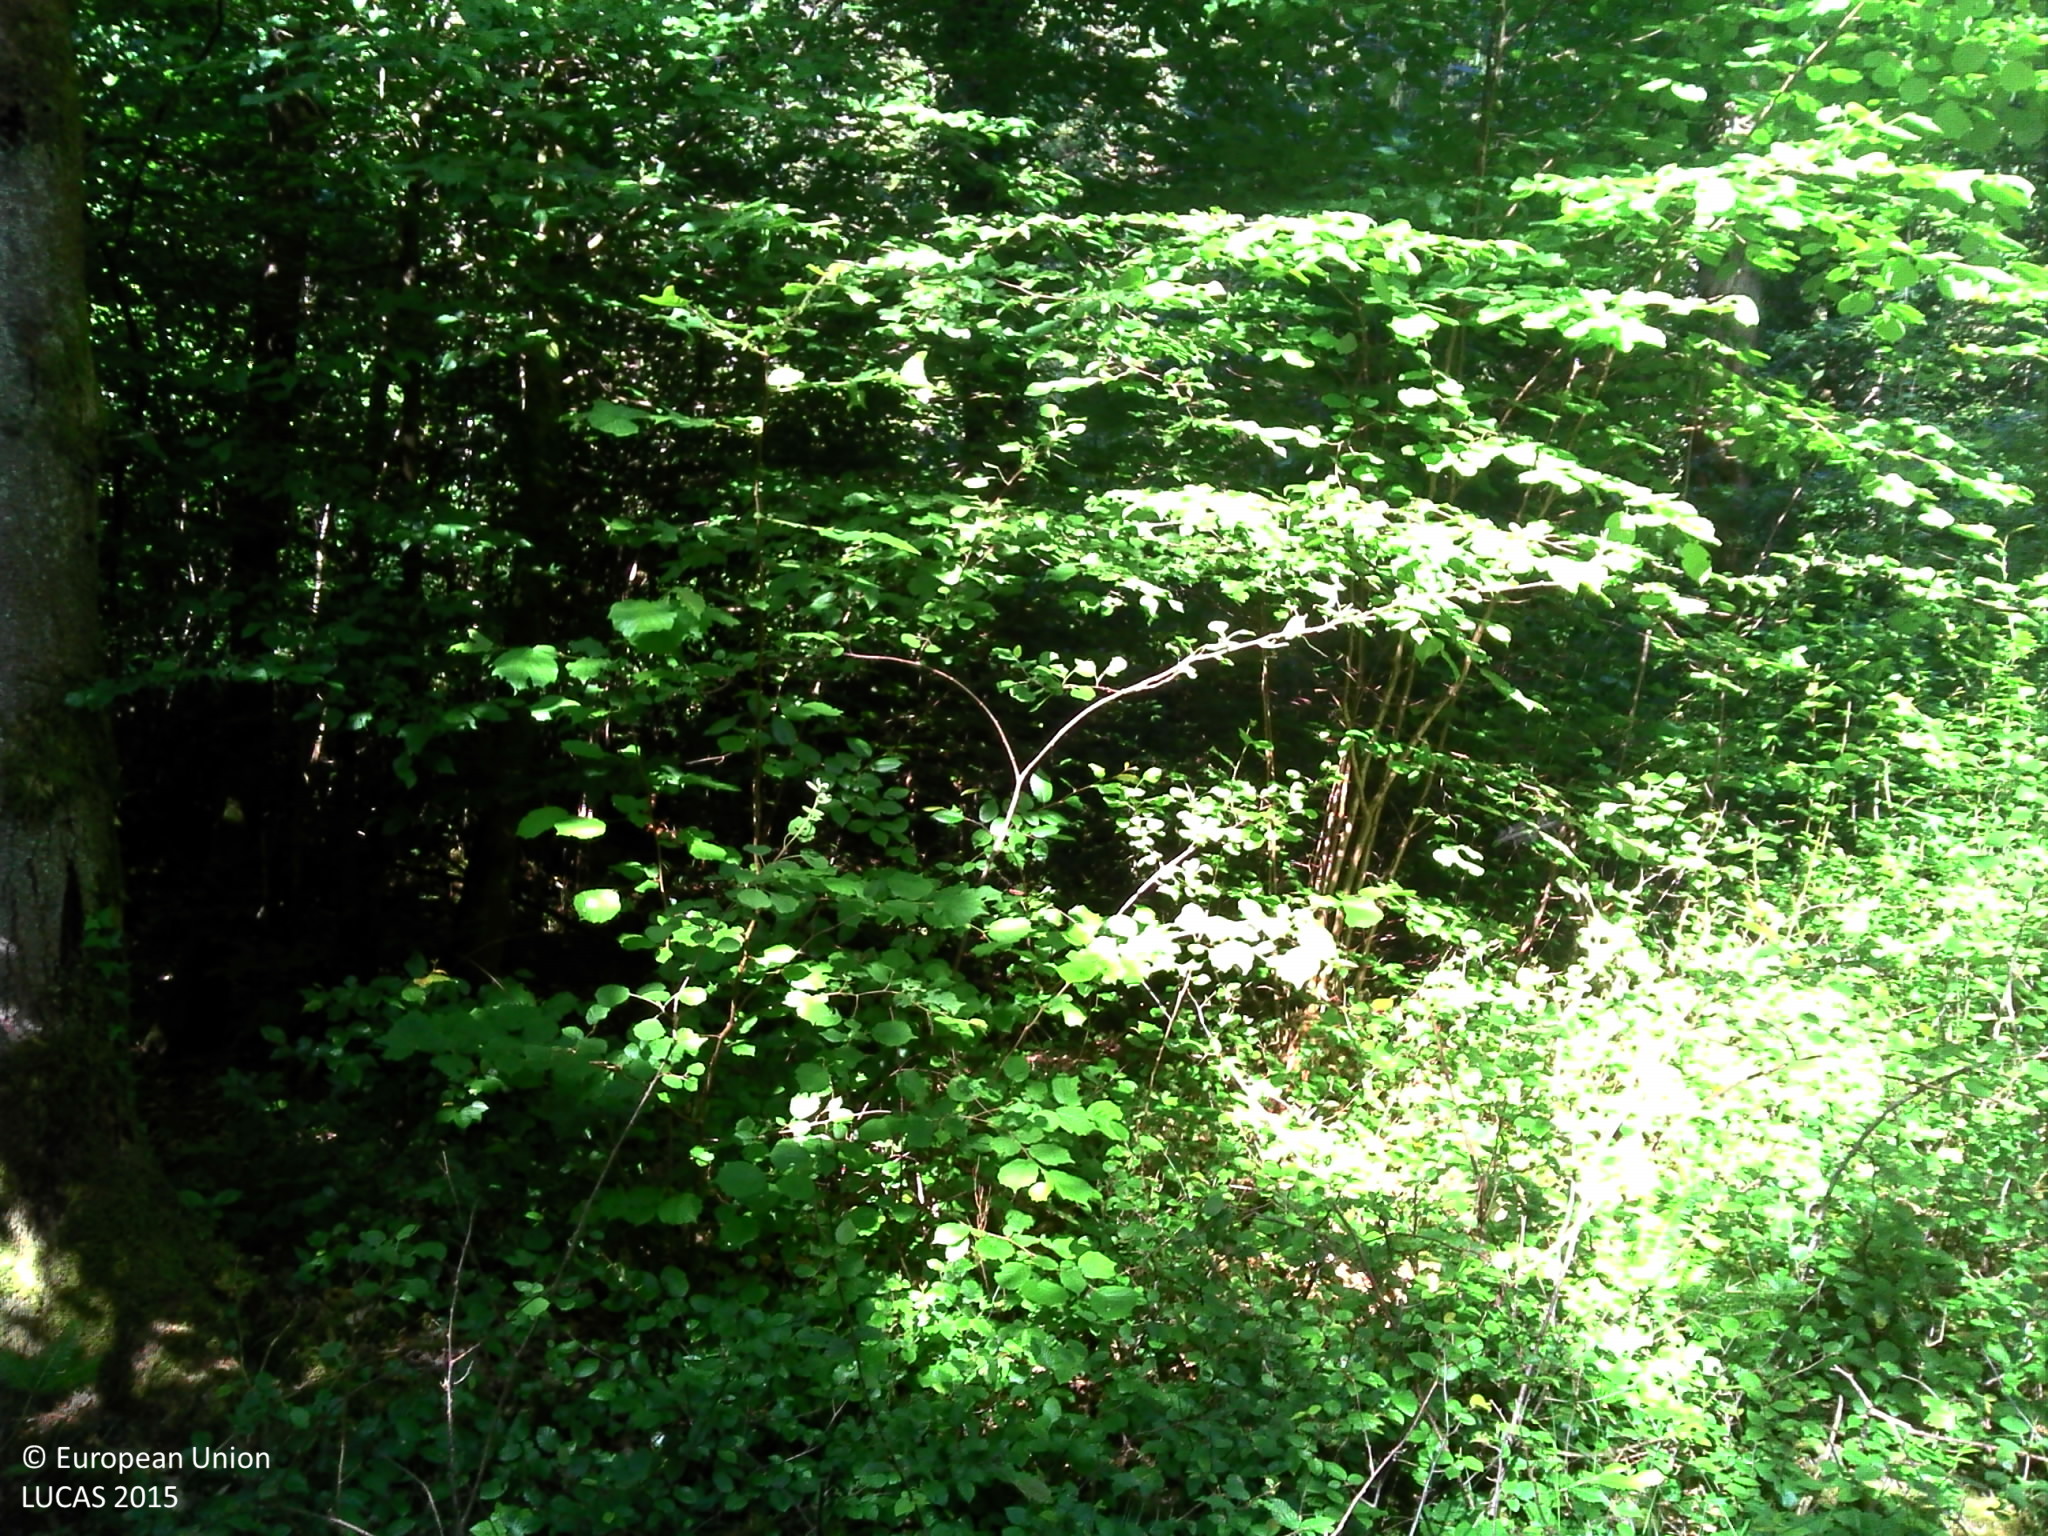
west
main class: Woodland
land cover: Spruce dominated mixed woodland
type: mesophytic deciduous forest
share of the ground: > 75 %
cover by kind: coniferous forest trees 45 %, broadleaved forest trees 45 %, herbaceous plants 10 %
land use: Forestry
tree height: > 5 m
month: June
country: FR
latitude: 47.7011
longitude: 6.0165
